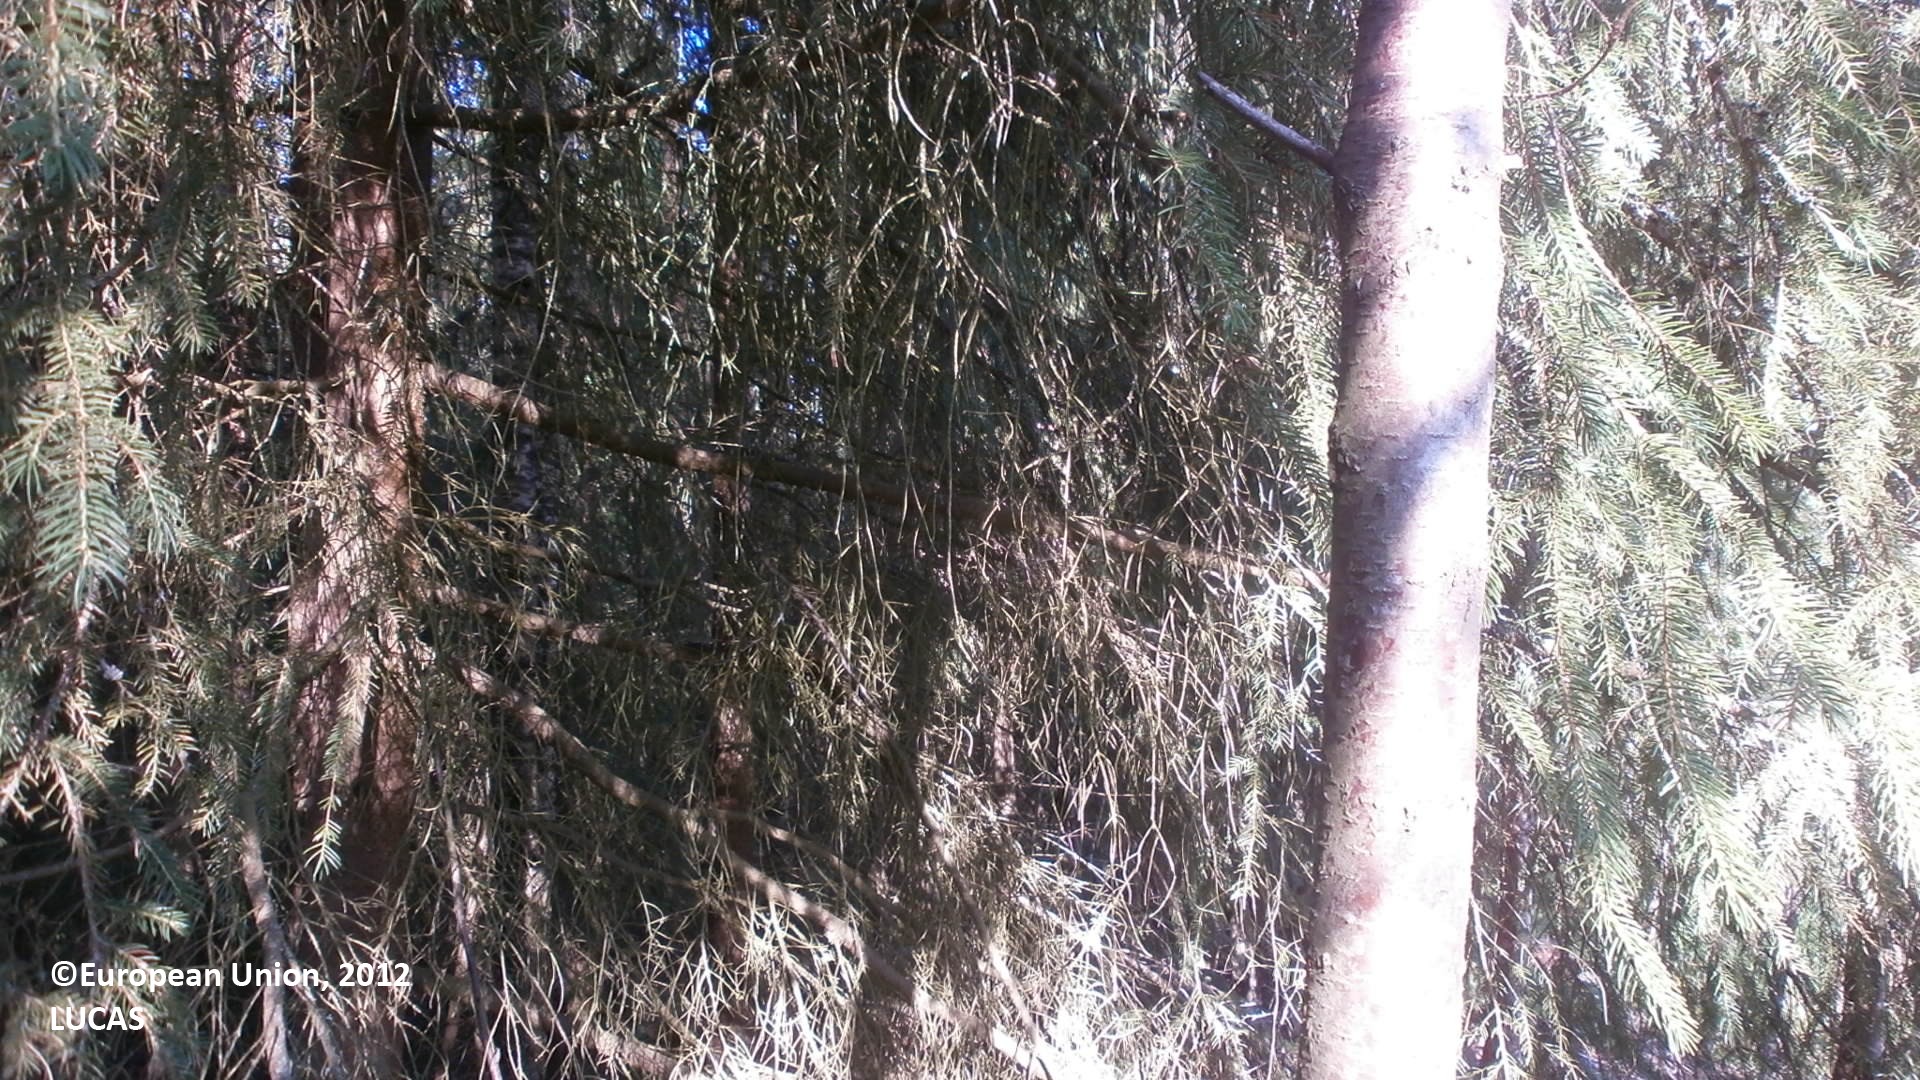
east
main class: Woodland
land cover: Spruce dominated mixed woodland
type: boreal forest
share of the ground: > 75 %
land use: Forestry
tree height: > 5 m
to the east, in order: Spruce dominated mixed woodland; Tracks; Pine dominated mixed woodland; Pine dominated coniferous woodland; Broadleaved woodland; Electric lines; Broadleaved woodland; Spruce dominated coniferous woodland; Shrubland with sparse tree cover; Ditches and canals; Abandoned hedges; Shruby margins; Paved roads, cycling and walking lanes; Shruby margins; Ditches and canals; Pine dominated coniferous woodland; Spruce dominated coniferous woodland
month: July
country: FI
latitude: 64.1156
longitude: 23.6704
